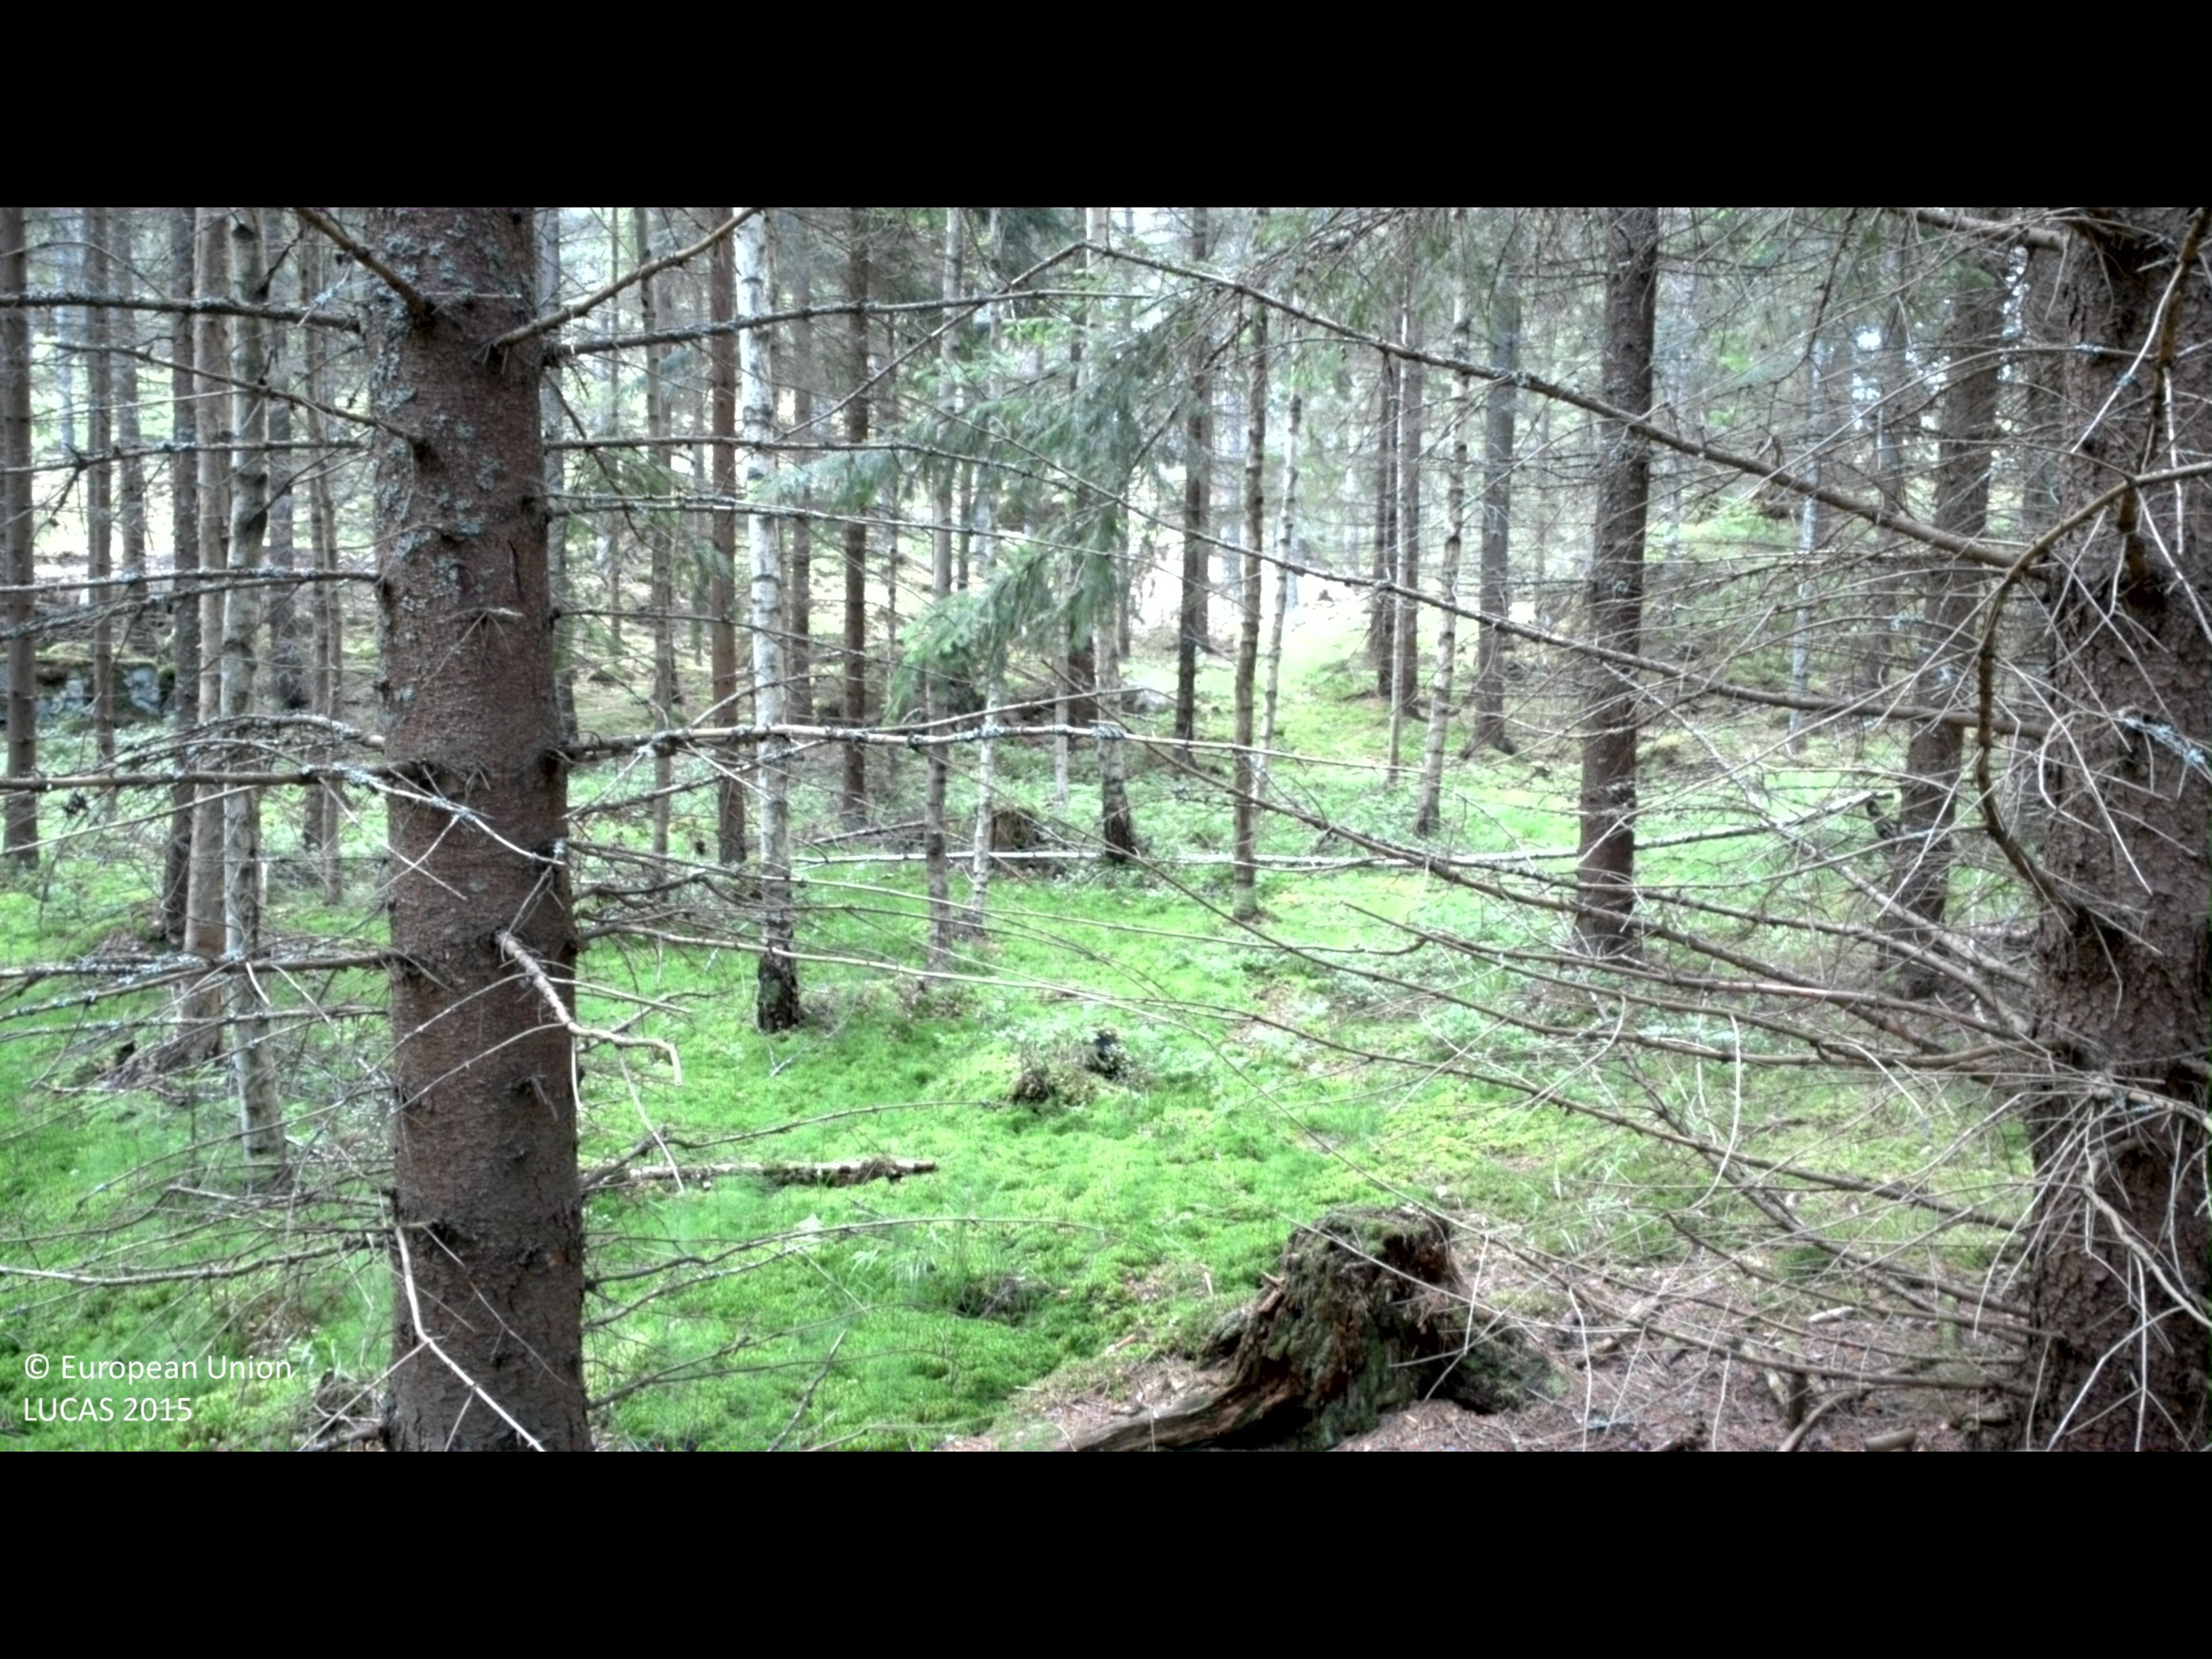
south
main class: Woodland
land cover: Spruce dominated coniferous woodland
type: boreal forest
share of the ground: > 75 %
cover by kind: coniferous forest trees 70 %, broadleaved forest trees 15 %, lichens and mosses 10 %, shrubs 5 %
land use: Forestry
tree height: > 5 m
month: June
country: SE
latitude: 58.2430
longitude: 16.1115
